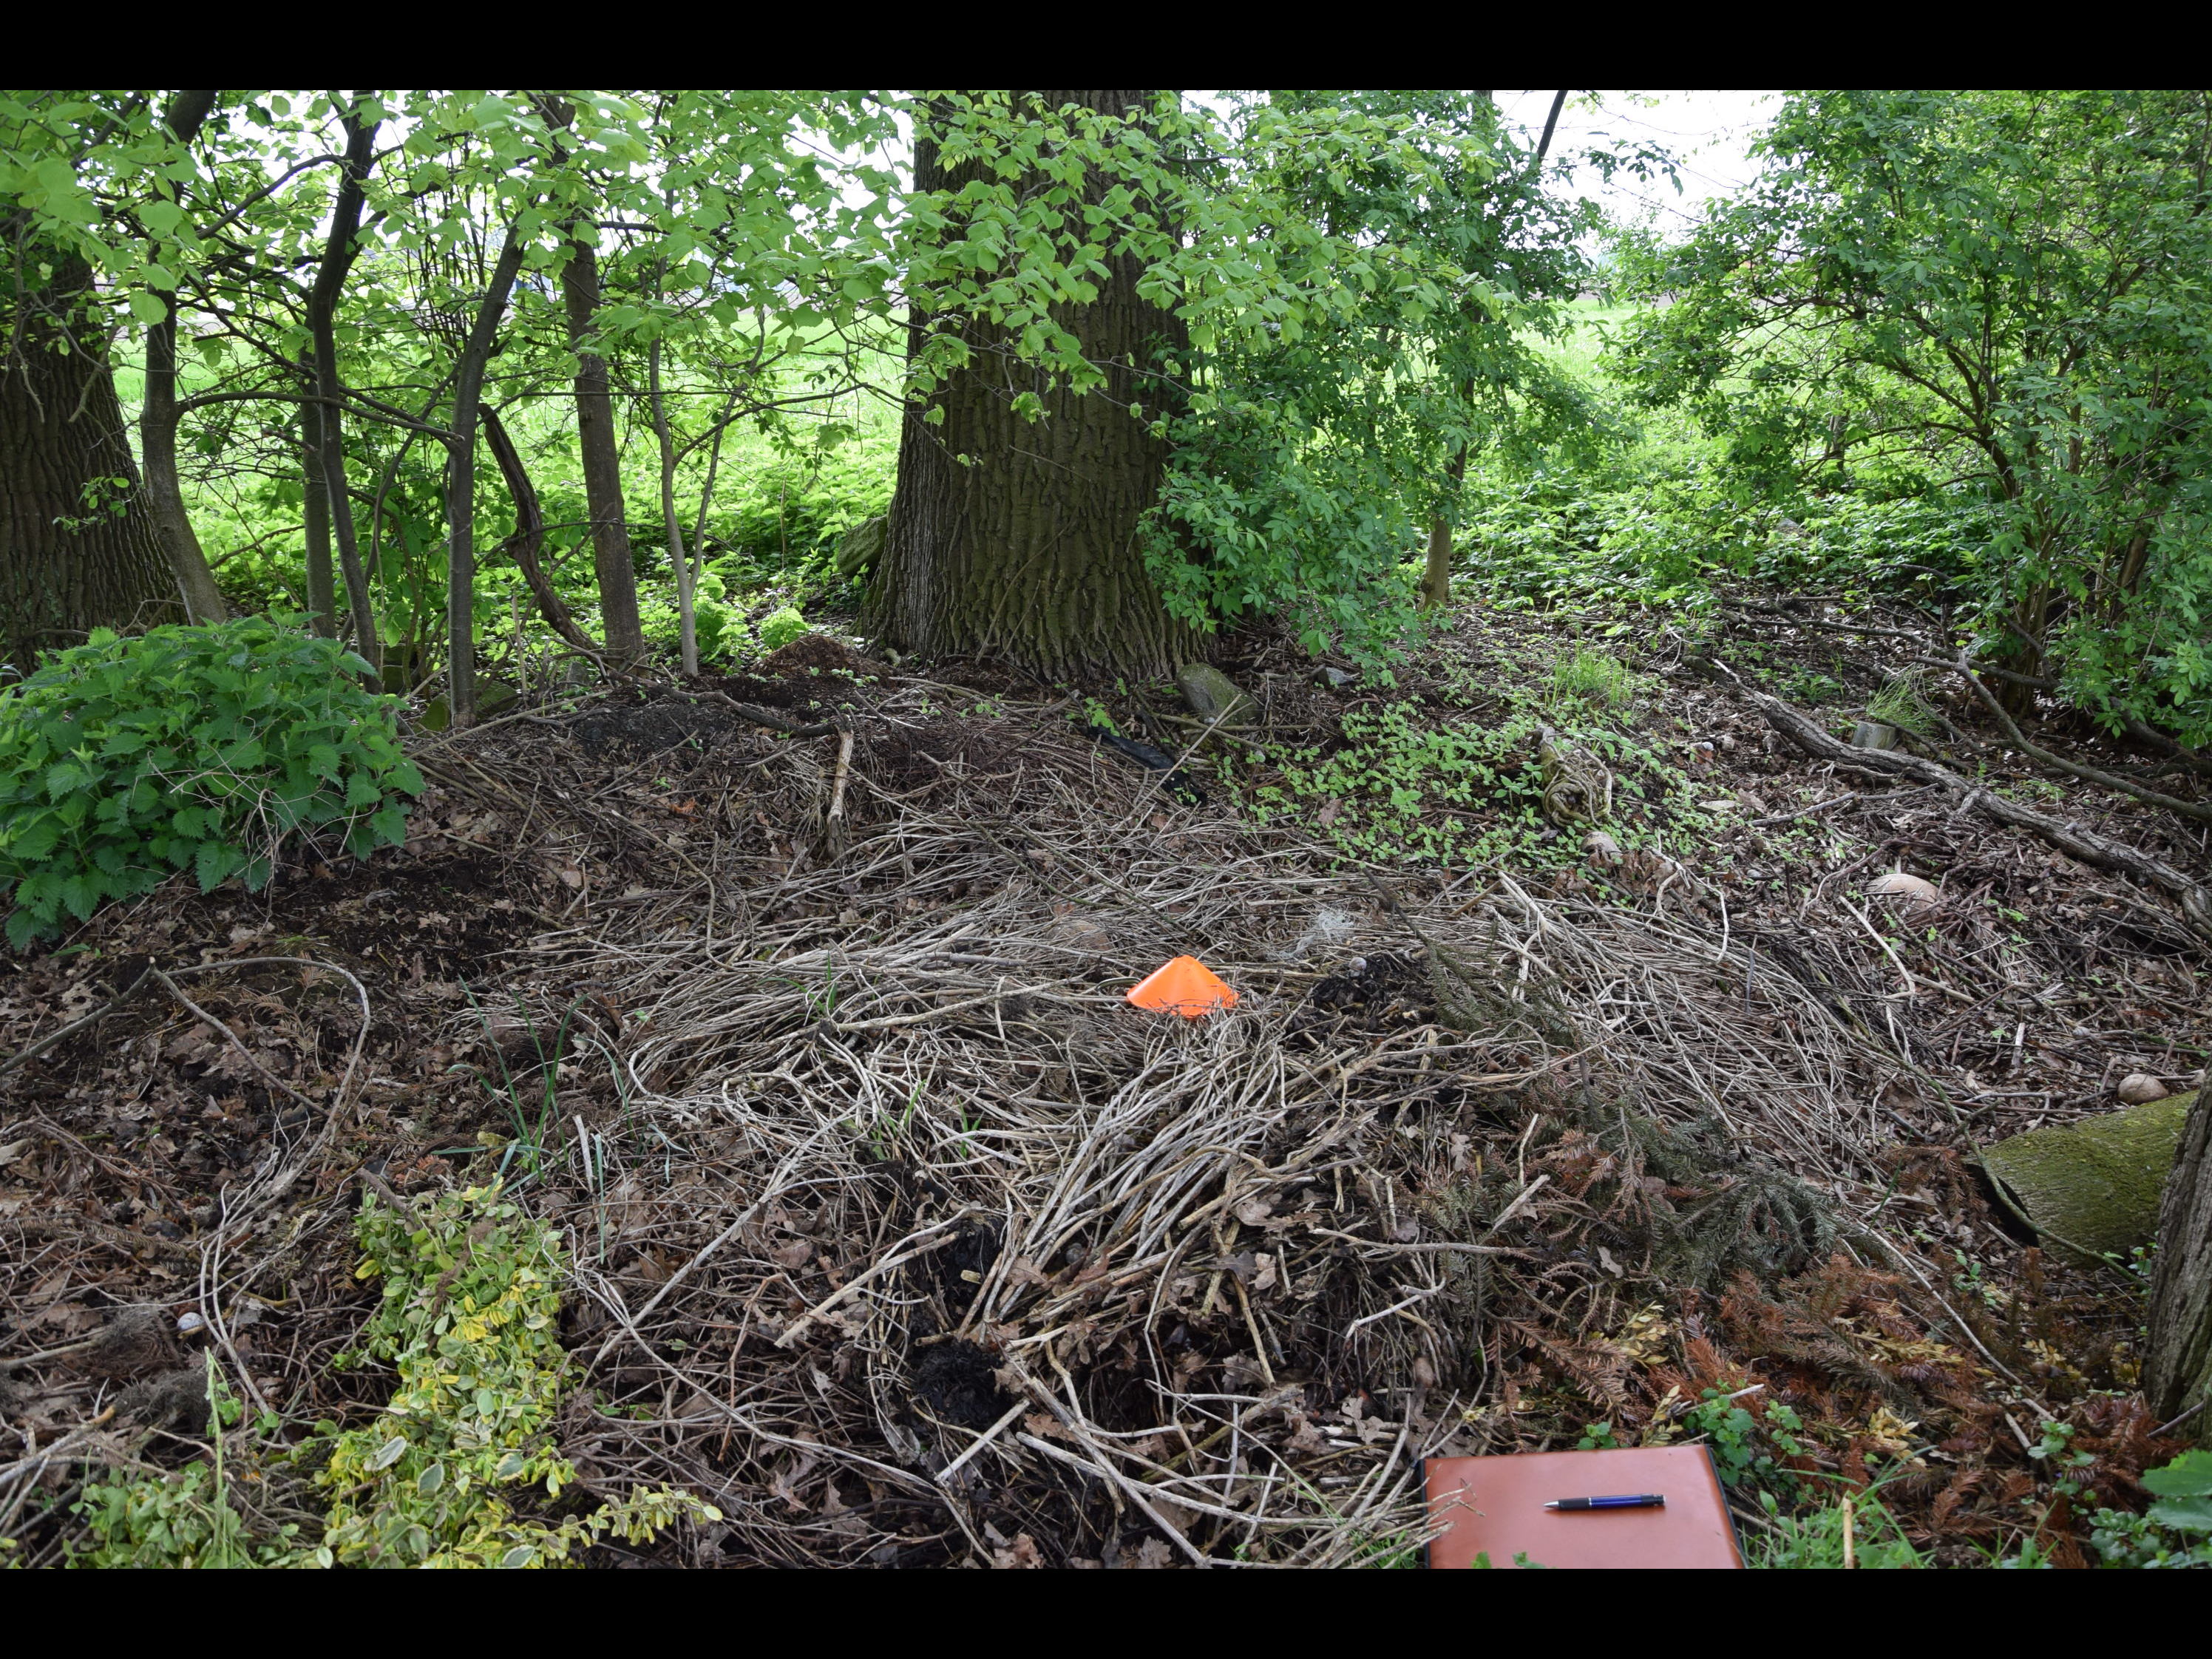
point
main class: Woodland
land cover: Broadleaved woodland
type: mesophytic deciduous forest
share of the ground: > 75 %
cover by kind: broadleaved forest trees 90 %, shrubs 5 %, herbaceous plants 5 %
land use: Forestry
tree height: > 5 m
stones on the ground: 10 - 25 %
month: May
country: AT
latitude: 48.2349
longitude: 14.6186
